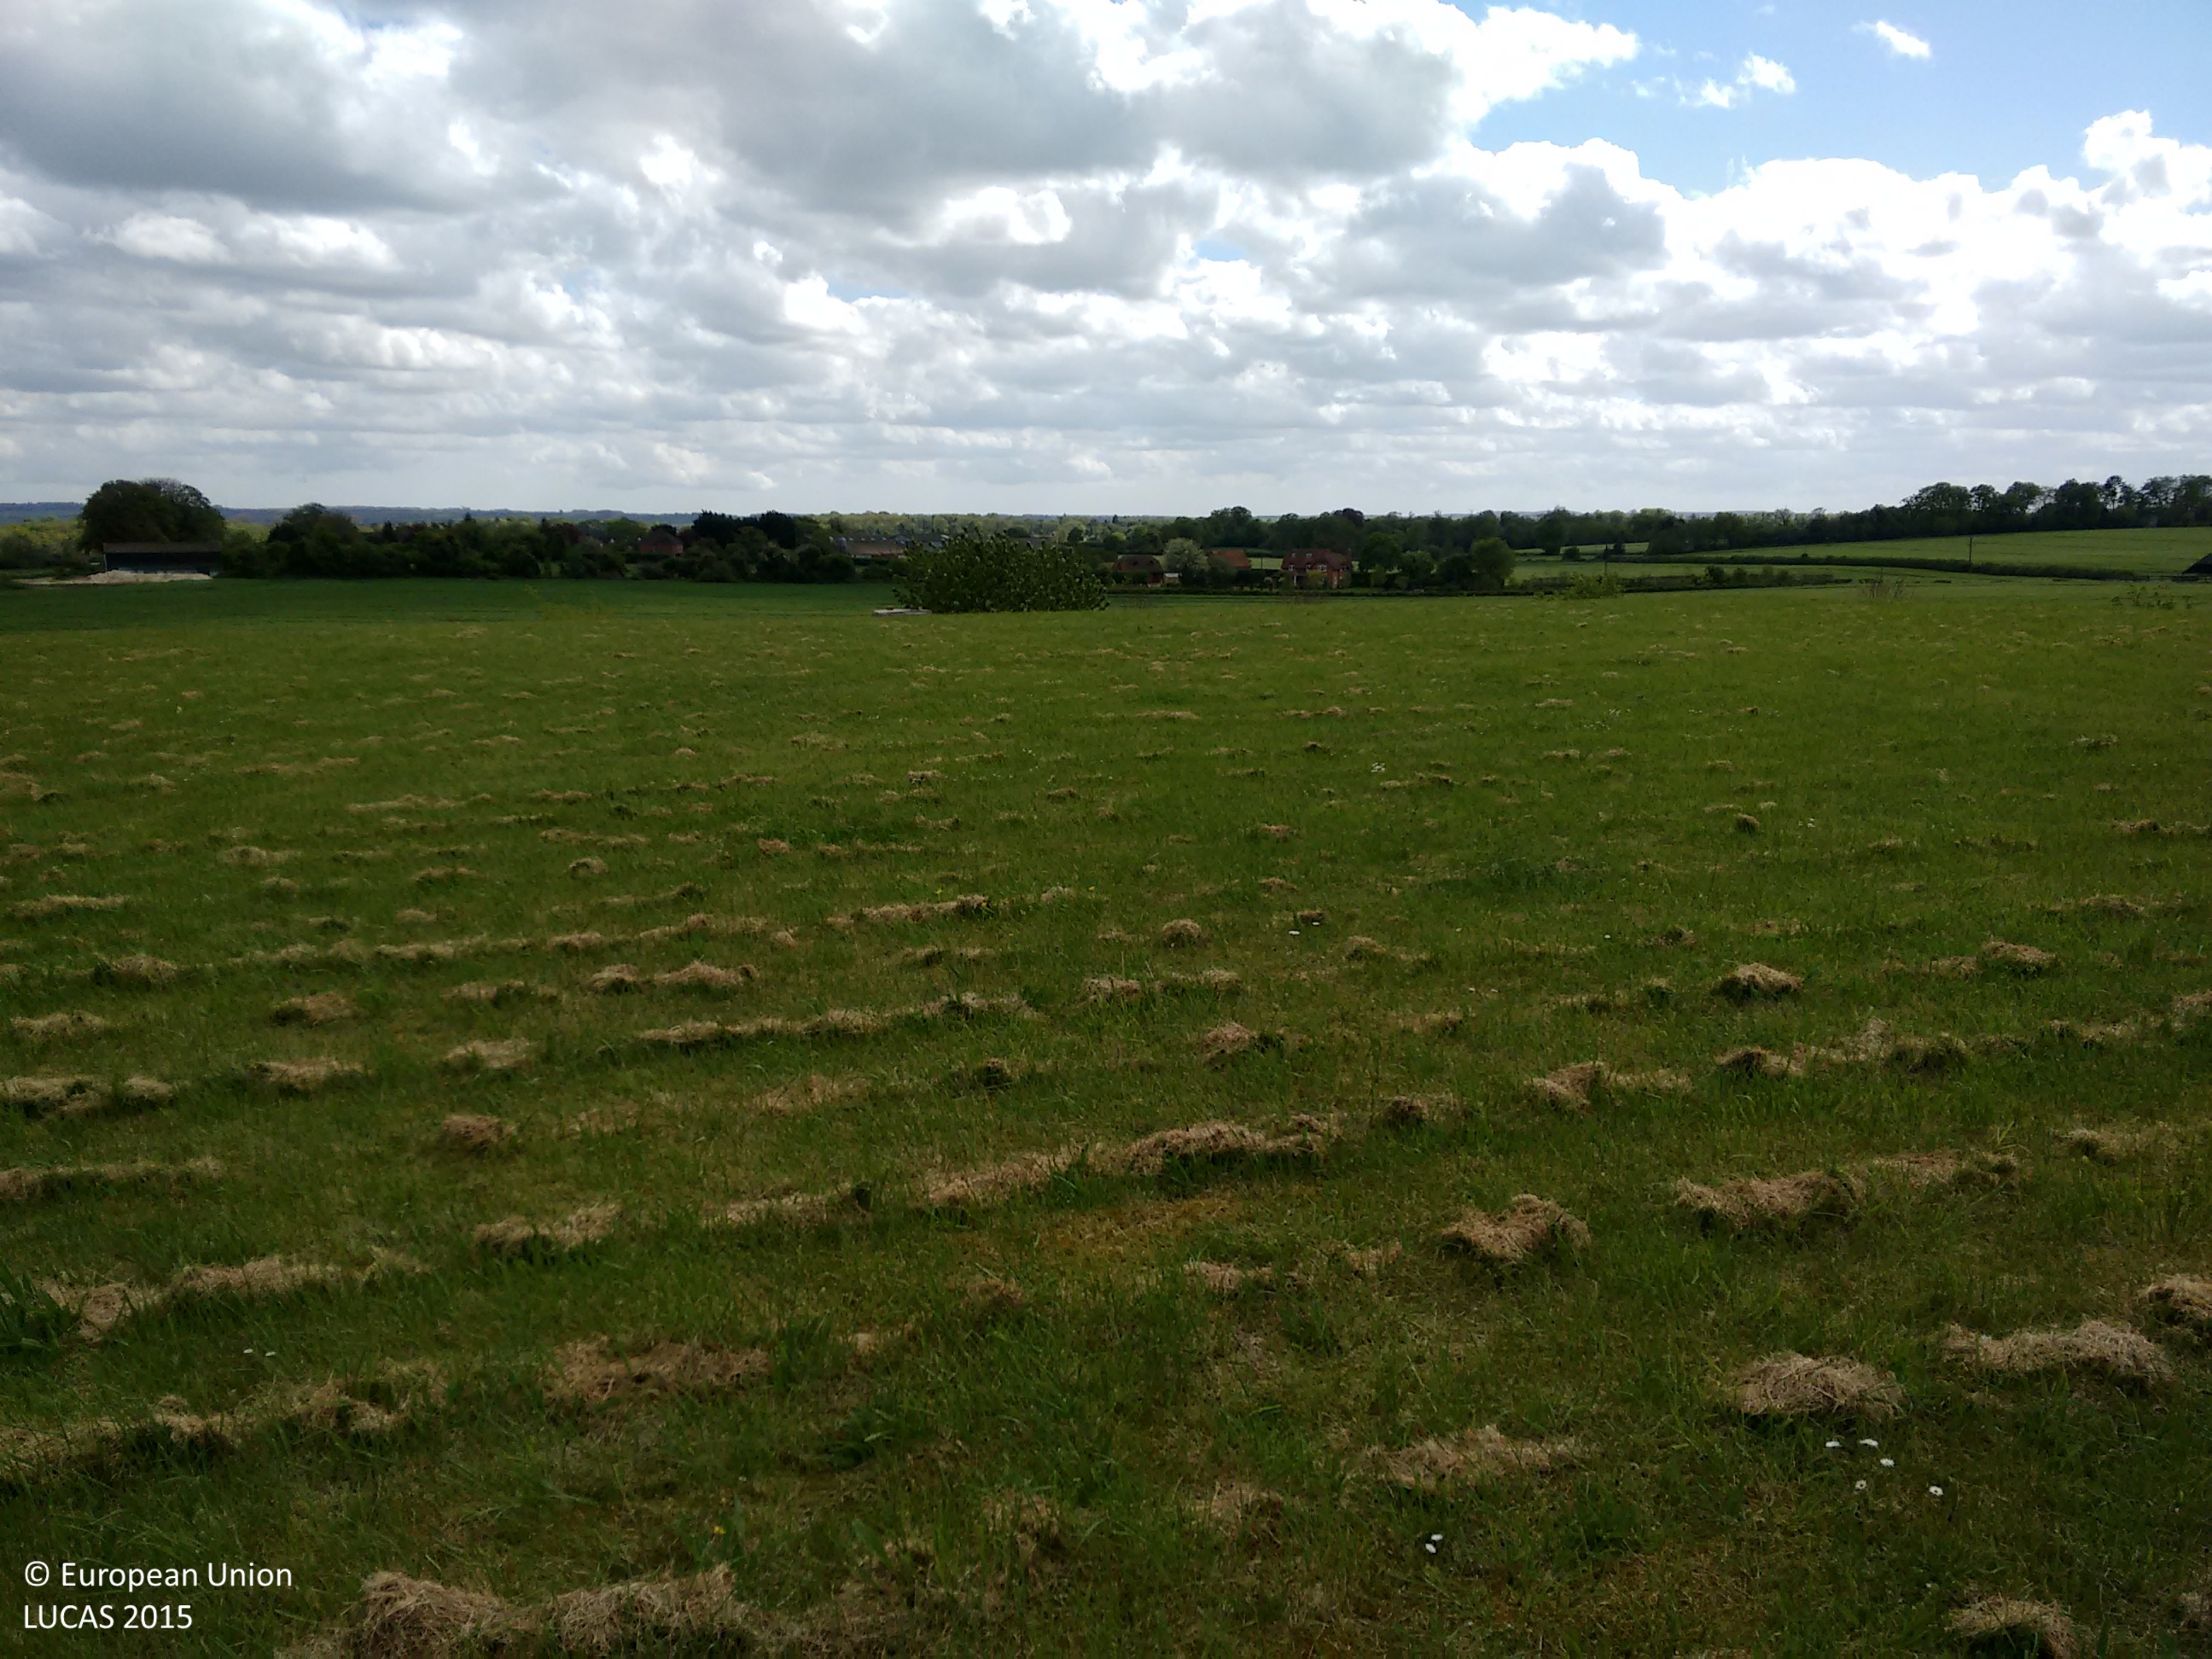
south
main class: Grassland
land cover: Grassland without tree/shrub cover
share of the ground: > 75 %
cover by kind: herbaceous plants 100 %
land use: Semi-natural and natural areas not in use
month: May
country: GB
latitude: 51.2867
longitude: -1.1589
